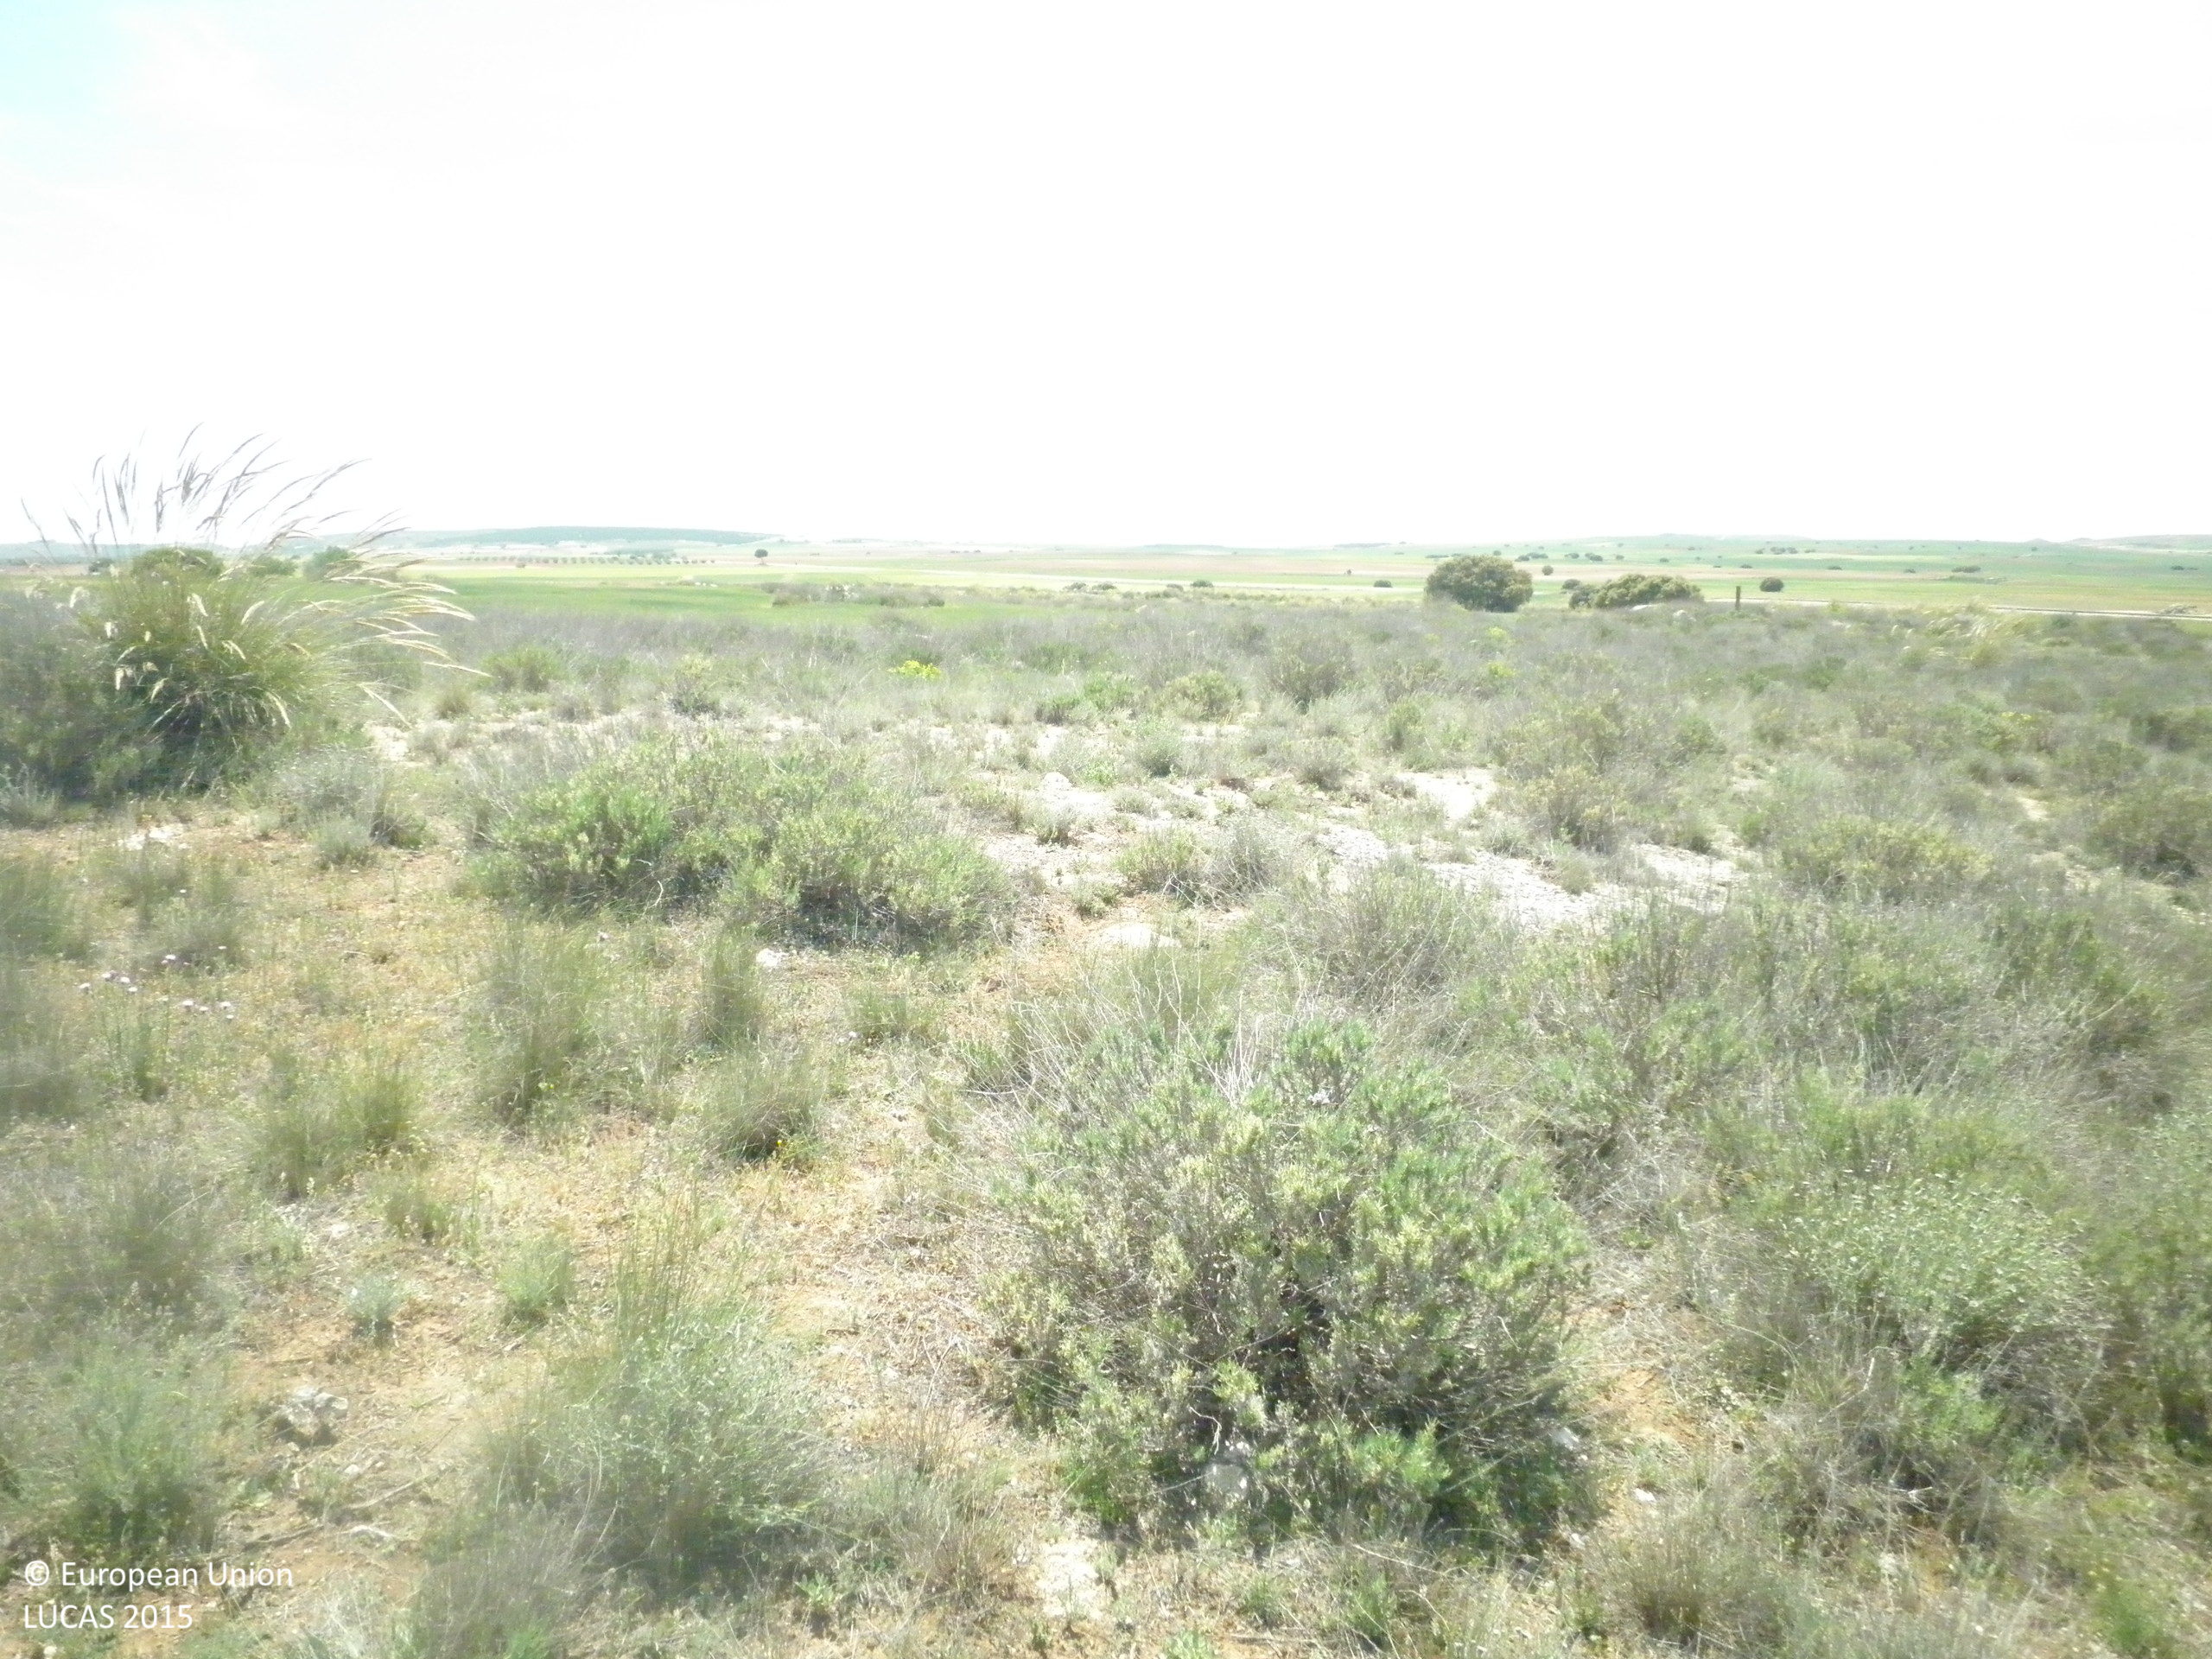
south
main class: Shrubland
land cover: Shrubland without tree cover
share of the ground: 50 - 75 %
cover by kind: unconsolidated bare surface 40 %, shrubs 30 %, herbaceous plants 30 %
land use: Semi-natural and natural areas not in use
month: May
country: ES
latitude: 39.6181
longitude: -2.7245
